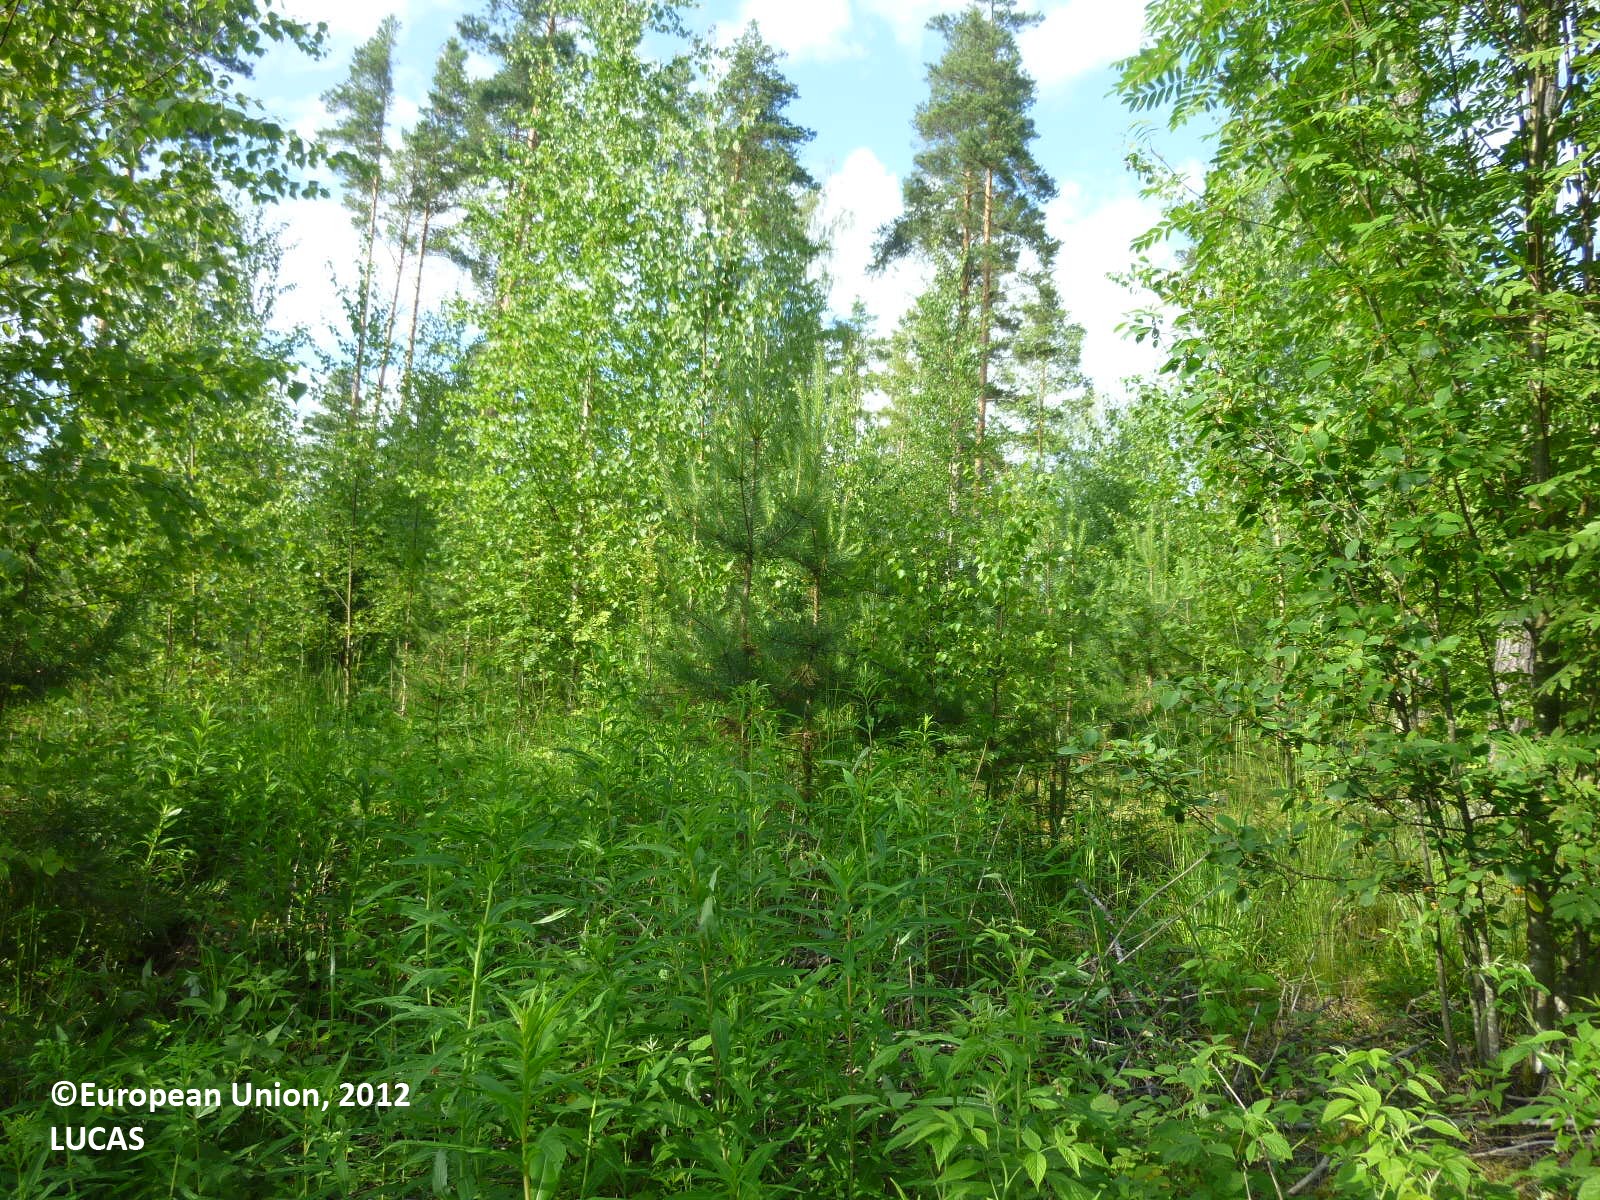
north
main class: Woodland
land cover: Pine dominated mixed woodland
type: boreal forest
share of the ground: 50 - 75 %
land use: Forestry
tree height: > 5 m
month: July
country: FI
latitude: 61.3878
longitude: 22.3609
